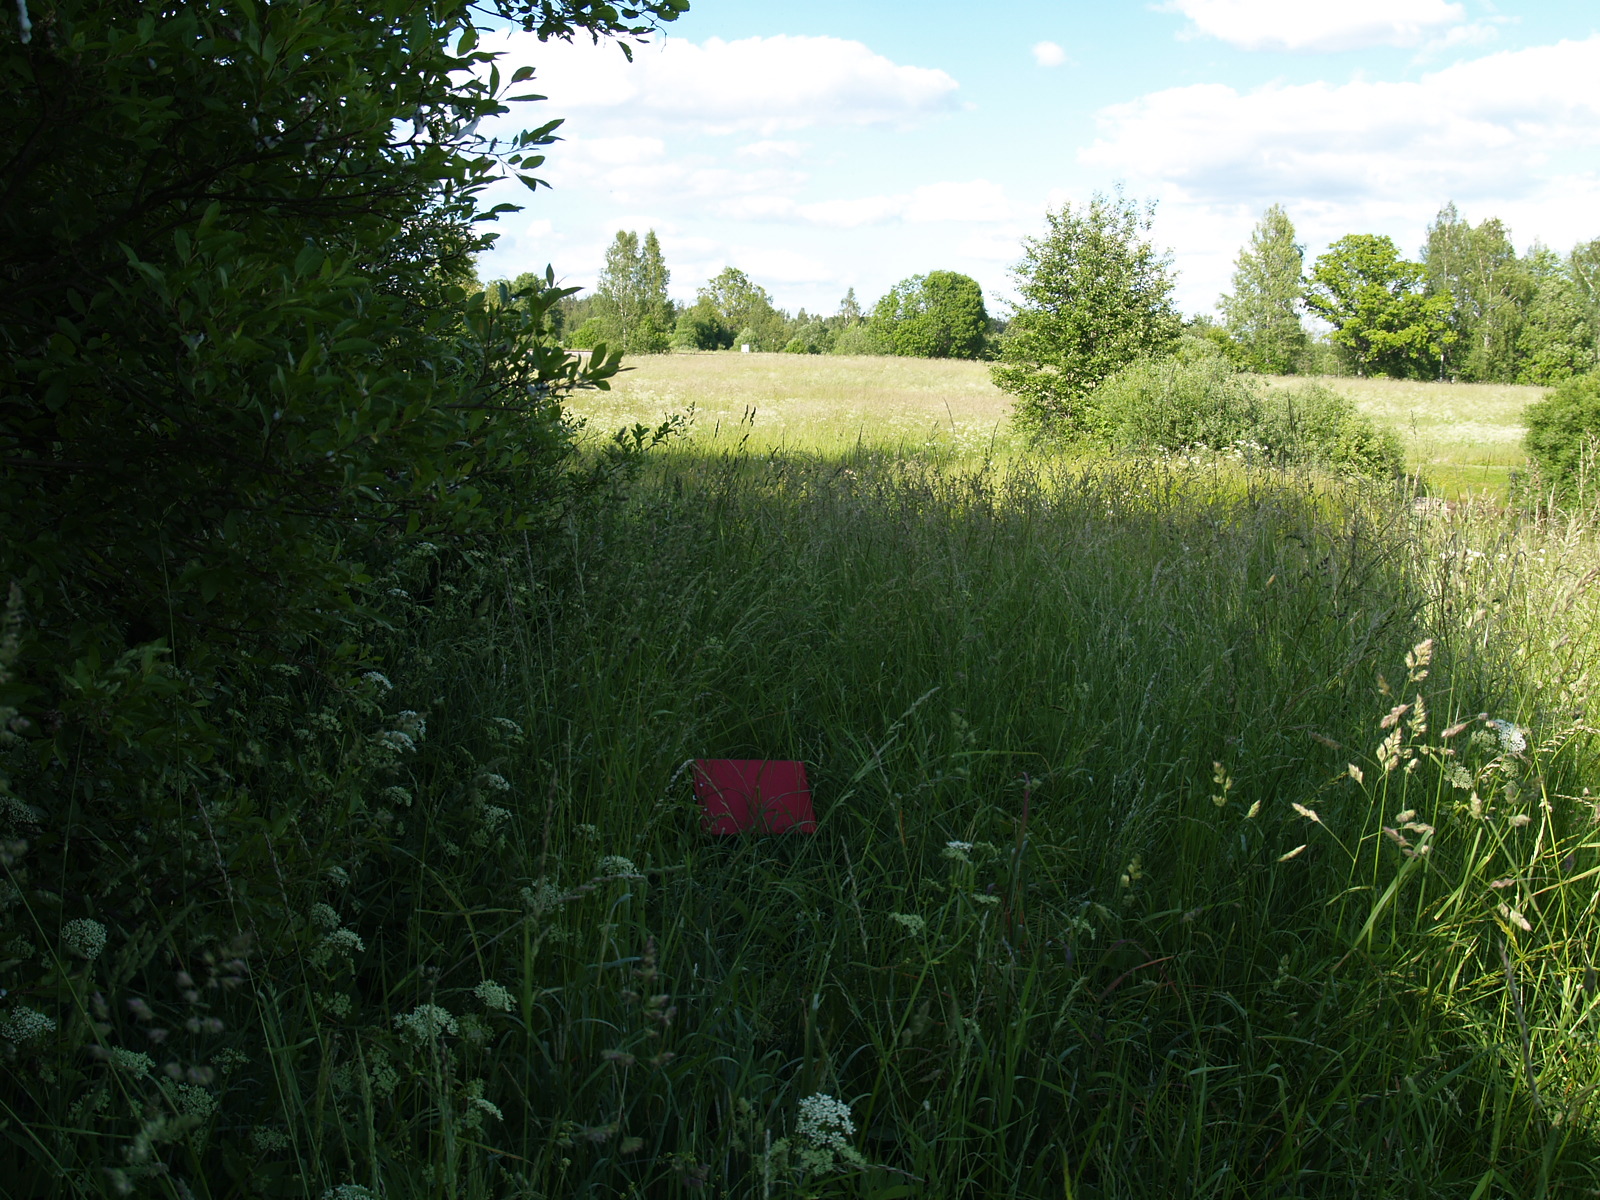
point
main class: Grassland
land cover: Grassland without tree/shrub cover
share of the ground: > 75 %
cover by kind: herbaceous plants 100 %
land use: Agriculture (excluding fallow land and kitchen gardens)
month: June
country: LV
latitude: 56.6139
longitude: 25.6520
